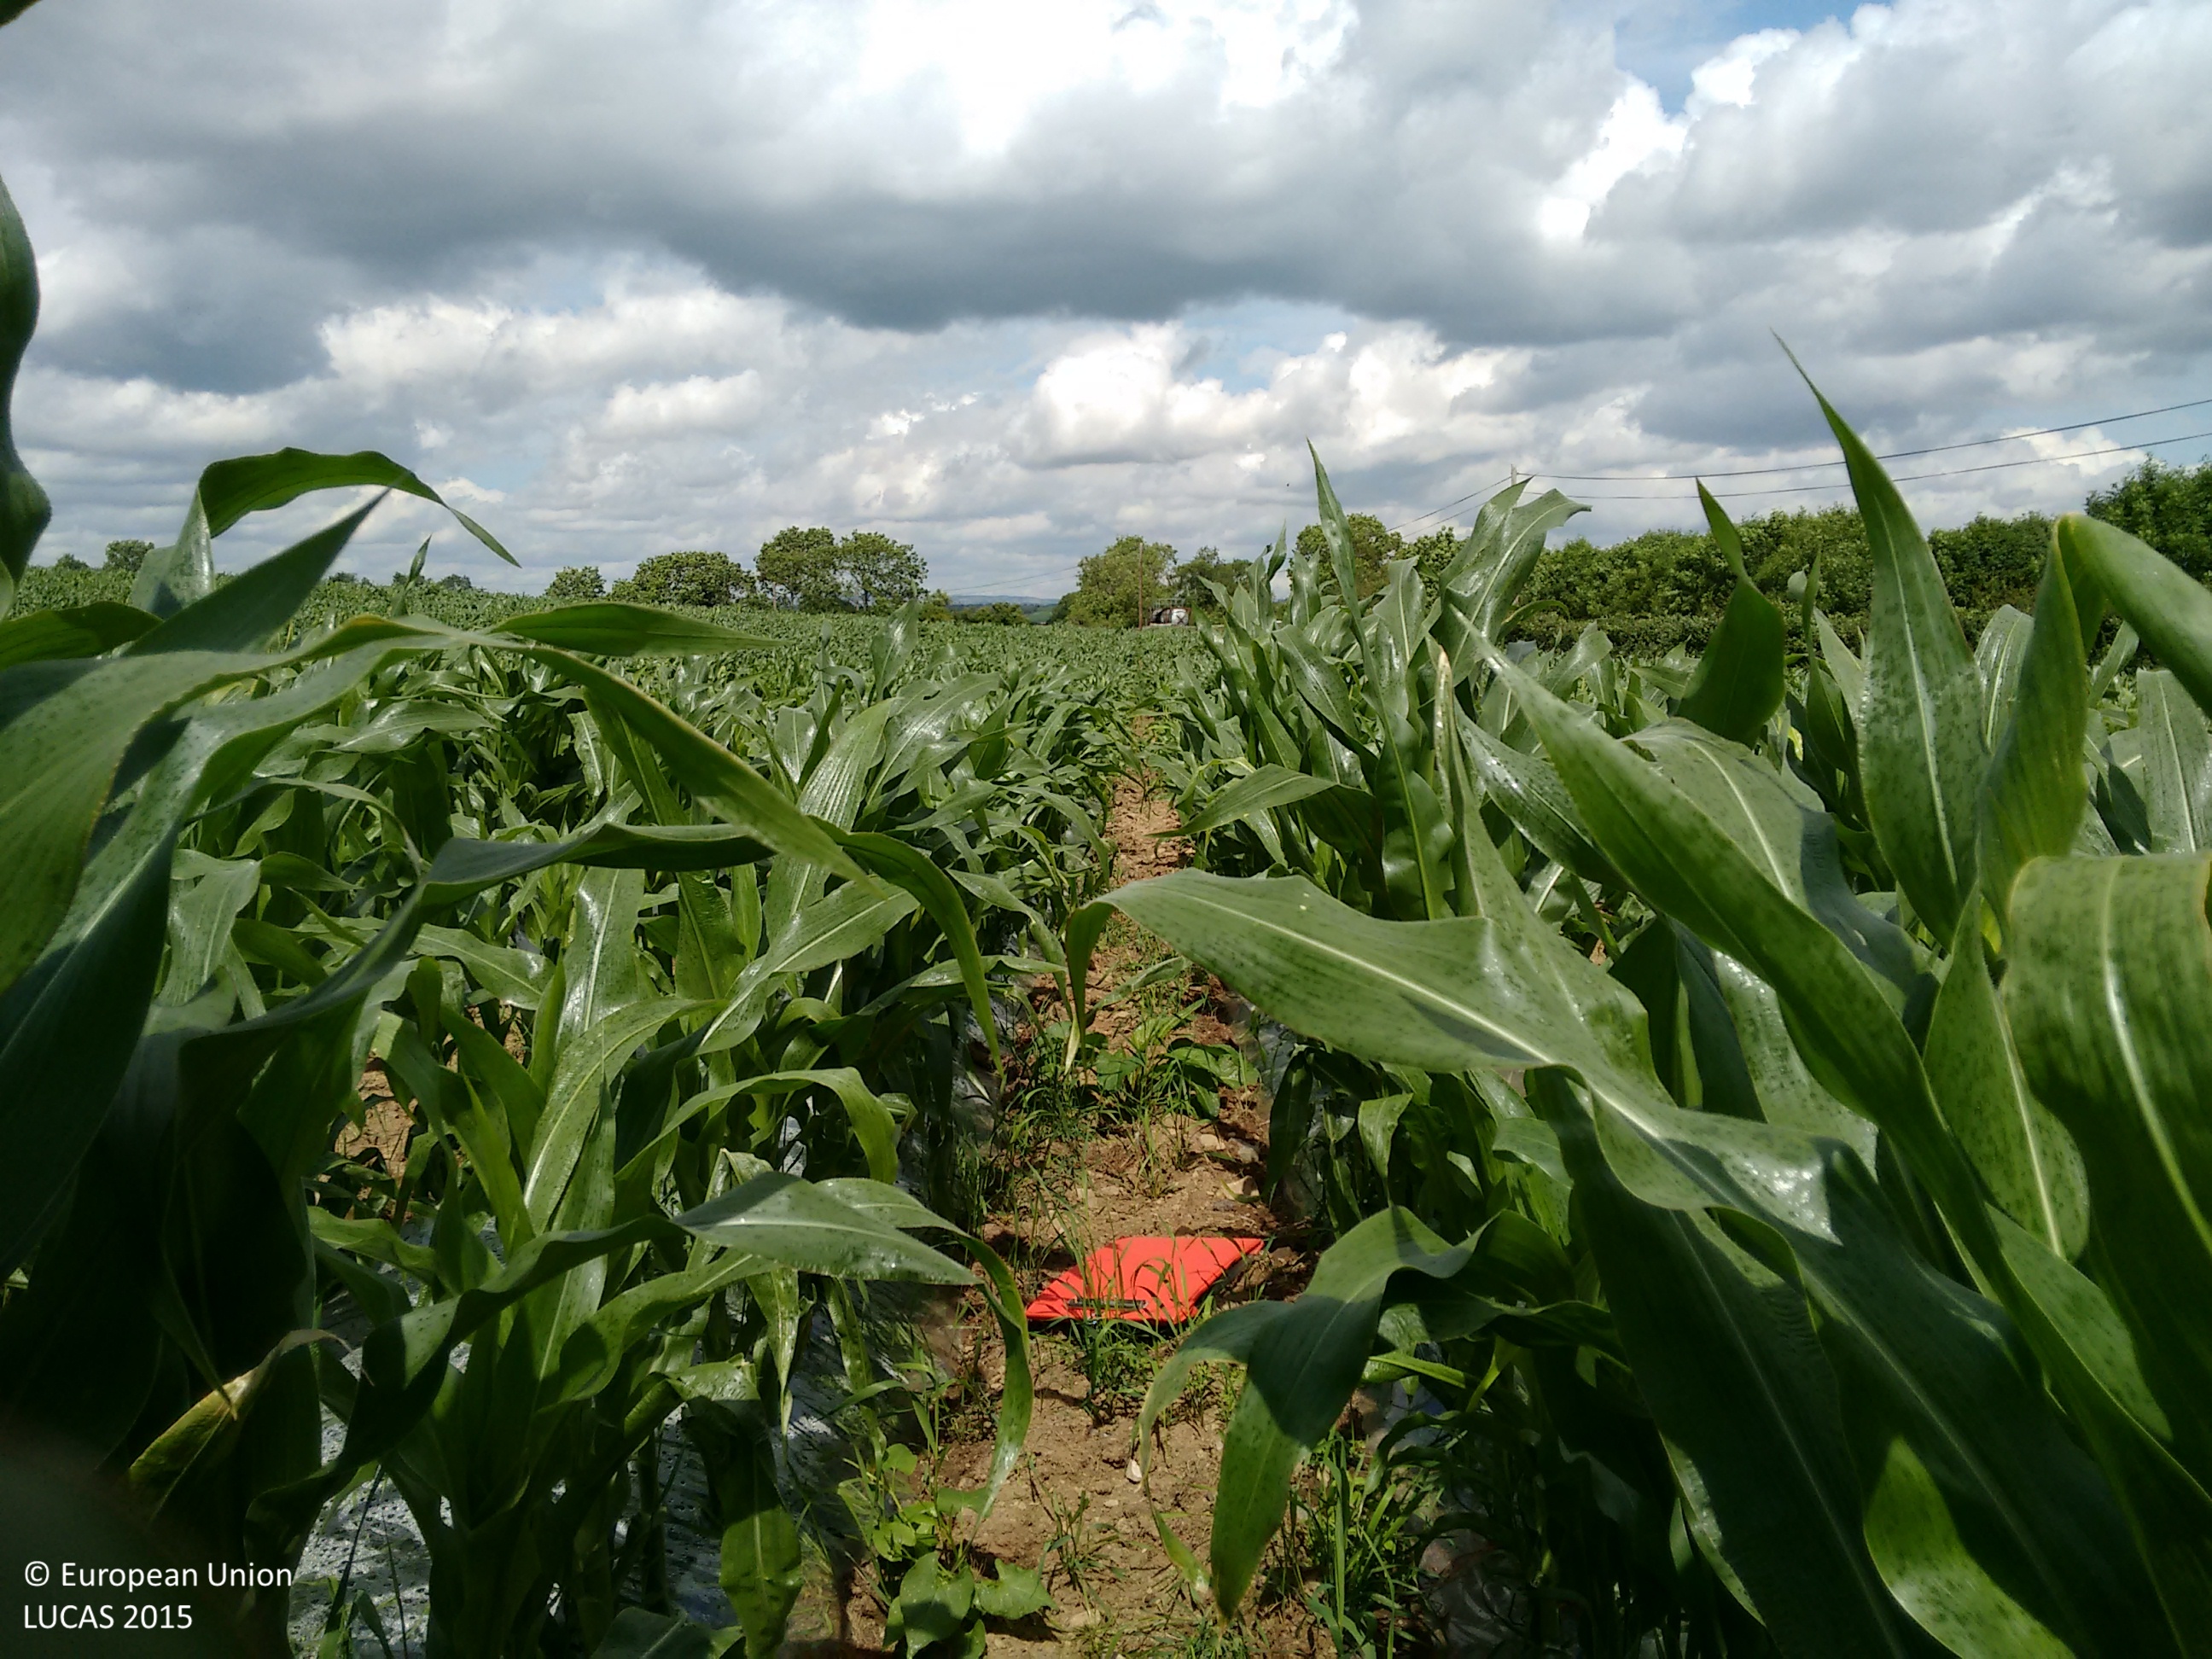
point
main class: Cropland
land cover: Maize
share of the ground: > 75 %
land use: Agriculture (excluding fallow land and kitchen gardens)
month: July
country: IE
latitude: 53.8073
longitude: -6.7308
